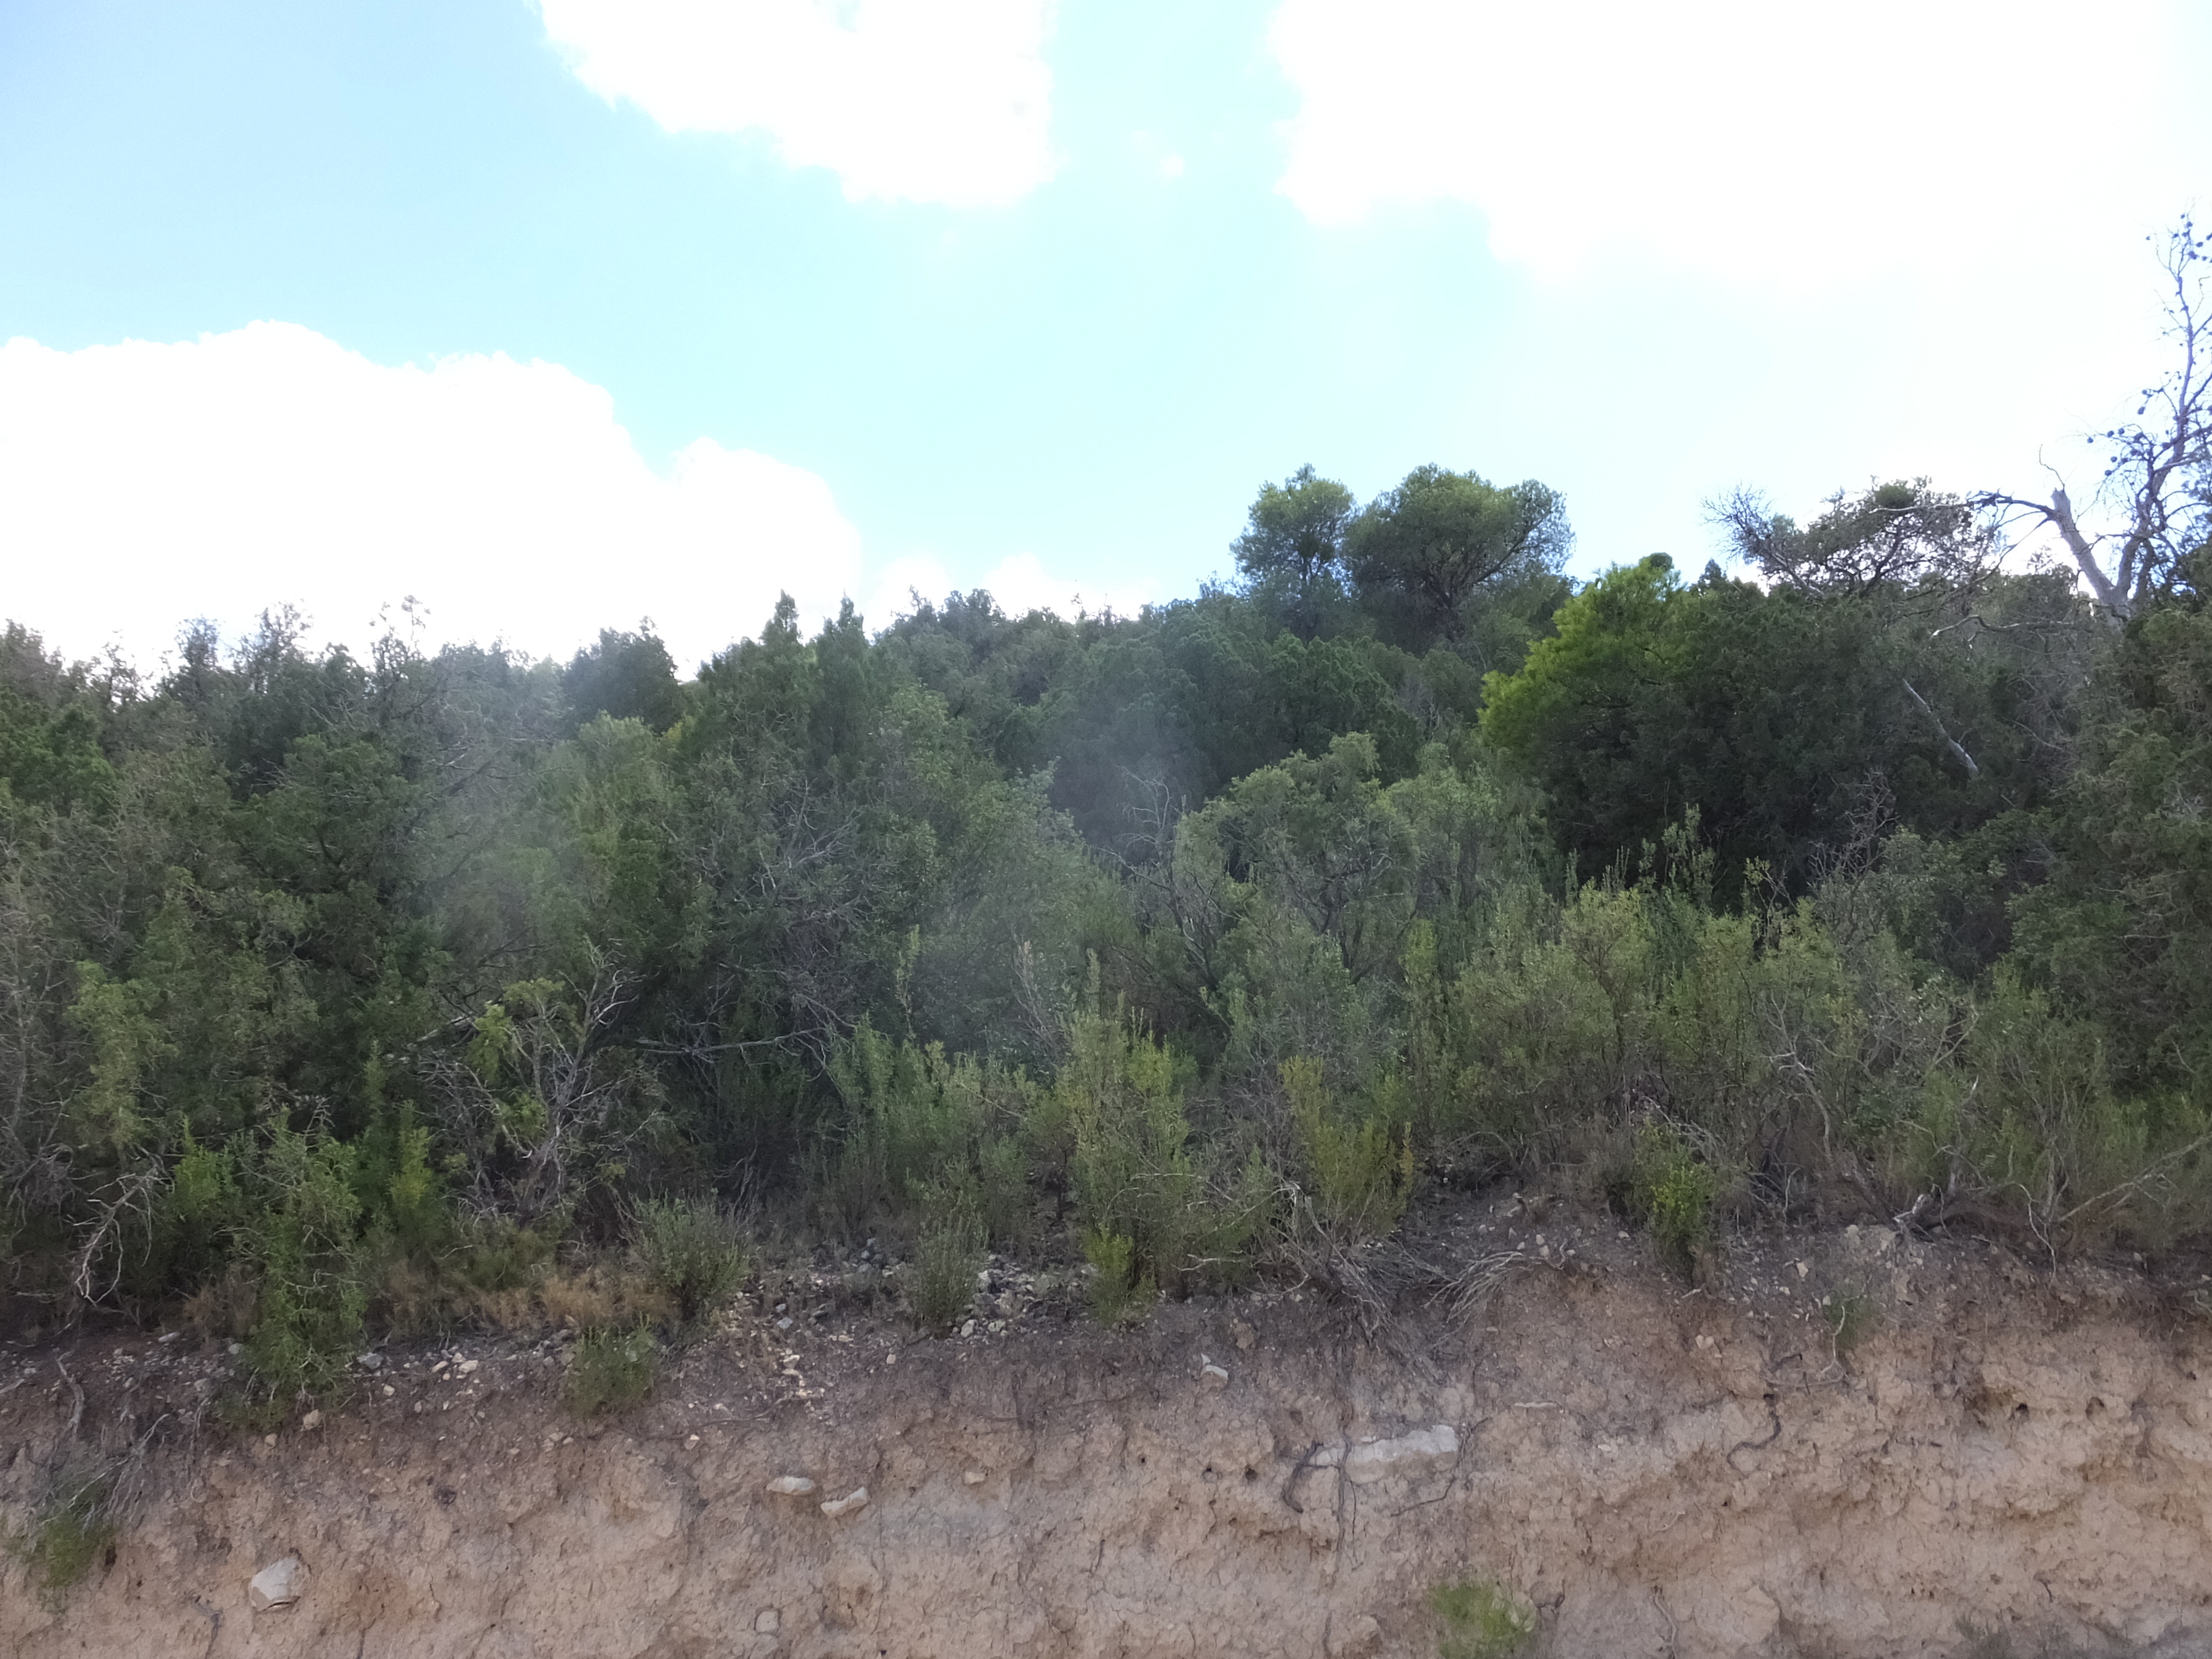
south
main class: Woodland
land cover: Pine dominated mixed woodland
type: coniferous forest of the mediterranean region
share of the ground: 50 - 75 %
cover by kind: coniferous forest trees 60 %, broadleaved forest trees 20 %, shrubs 10 %, herbaceous plants 10 %
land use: Forestry
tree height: > 5 m
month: August
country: ES
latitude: 41.3926
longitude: 0.1683
